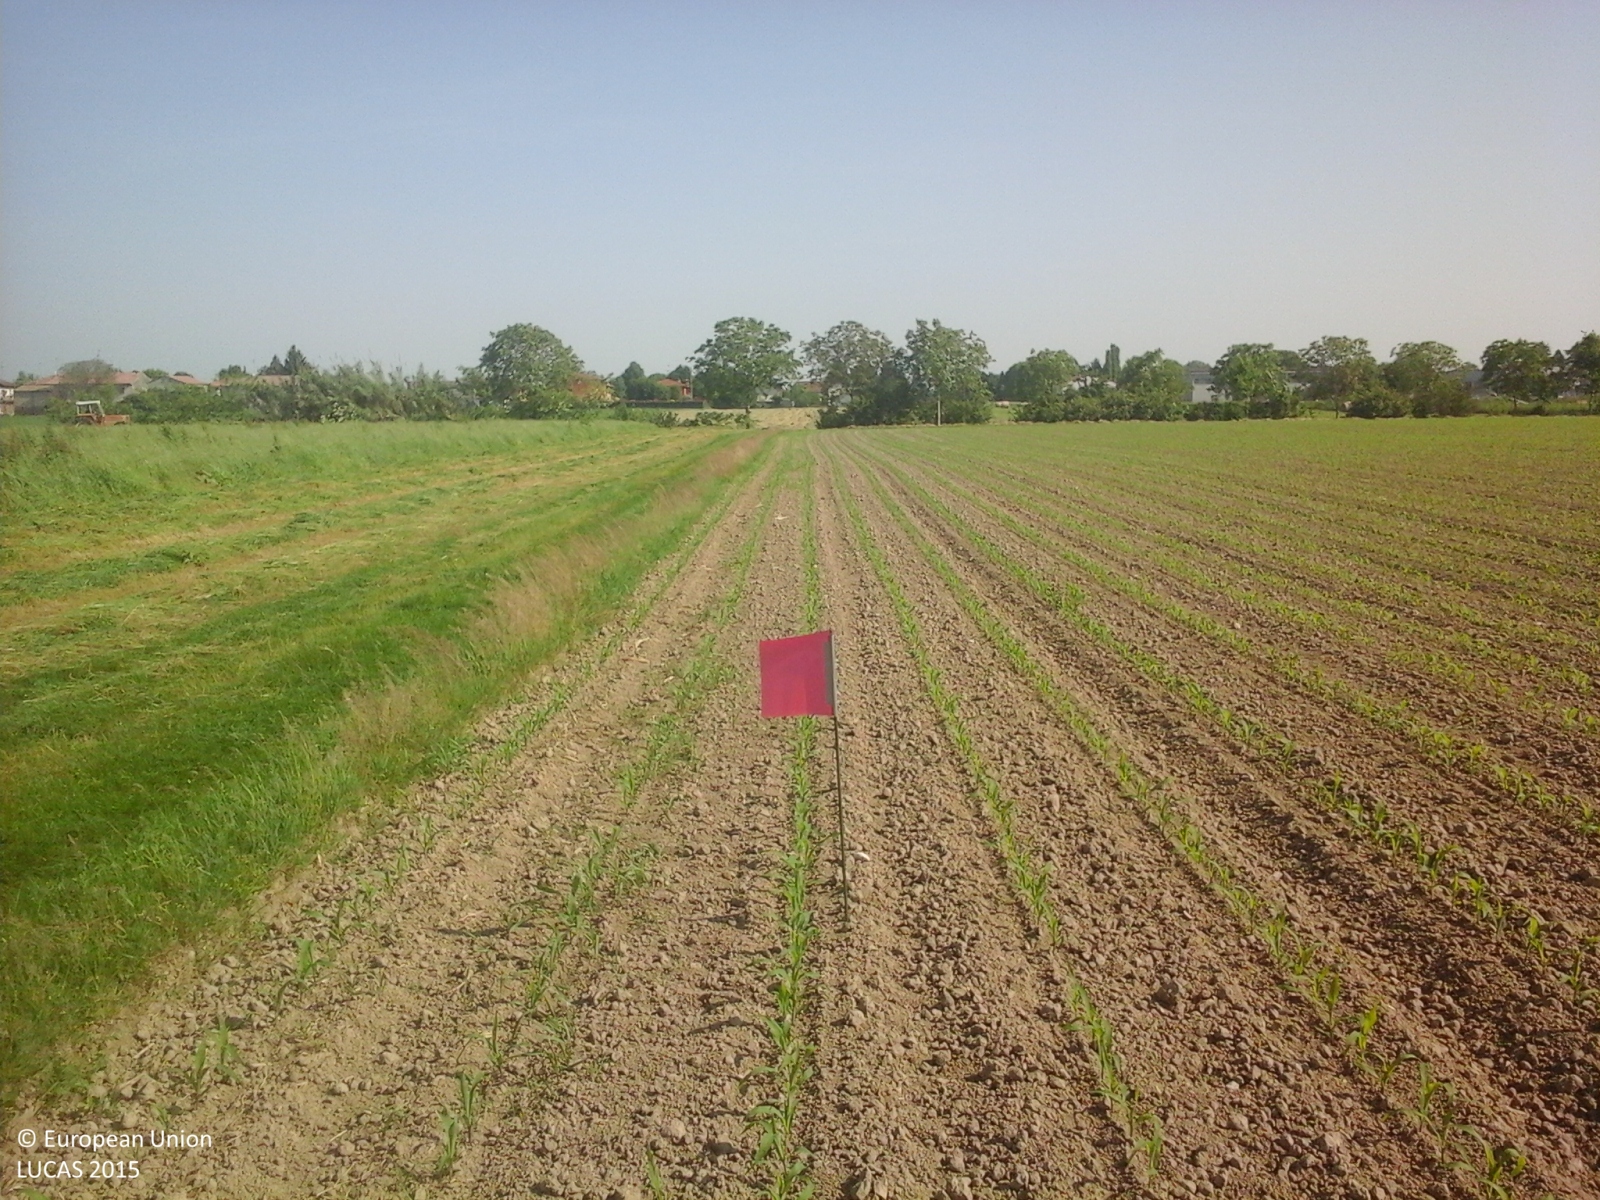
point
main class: Cropland
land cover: Maize
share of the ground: < 10 %
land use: Agriculture (excluding fallow land and kitchen gardens)
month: May
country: IT
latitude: 45.0497
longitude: 10.9251
